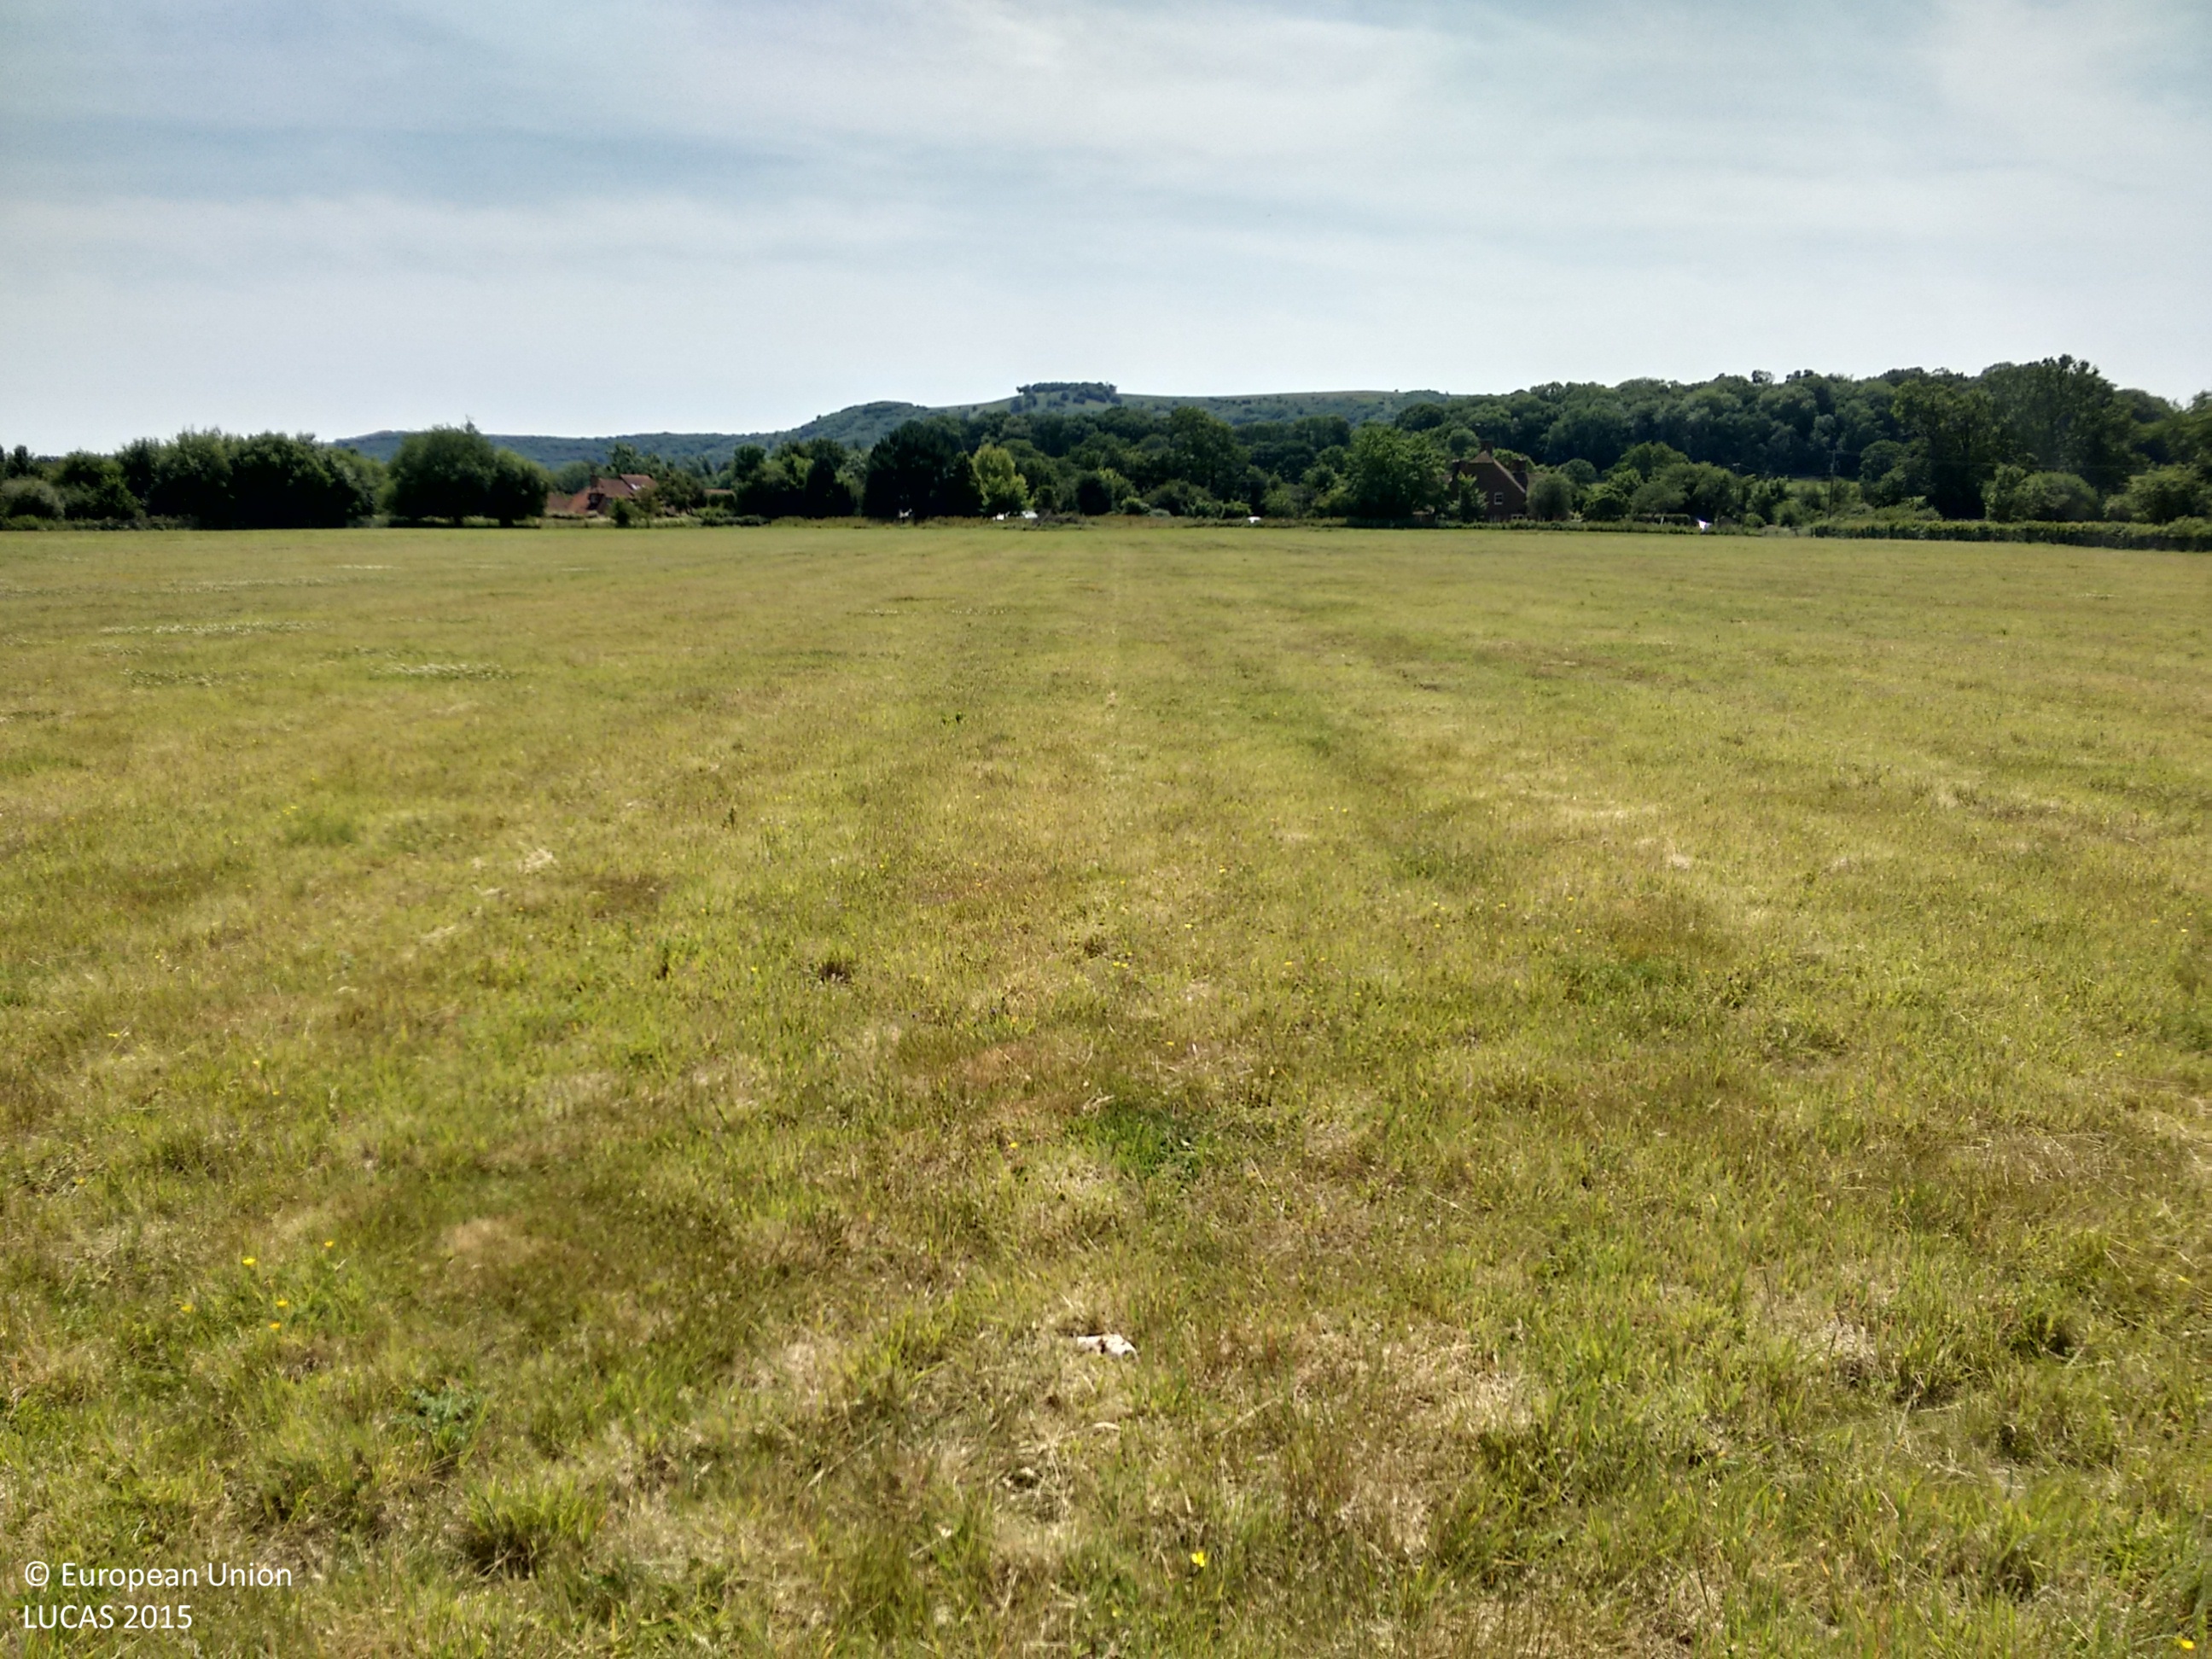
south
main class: Grassland
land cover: Grassland without tree/shrub cover
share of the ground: > 75 %
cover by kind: herbaceous plants 100 %
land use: Agriculture (excluding fallow land and kitchen gardens)
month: July
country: GB
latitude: 50.9240
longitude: -0.3795
